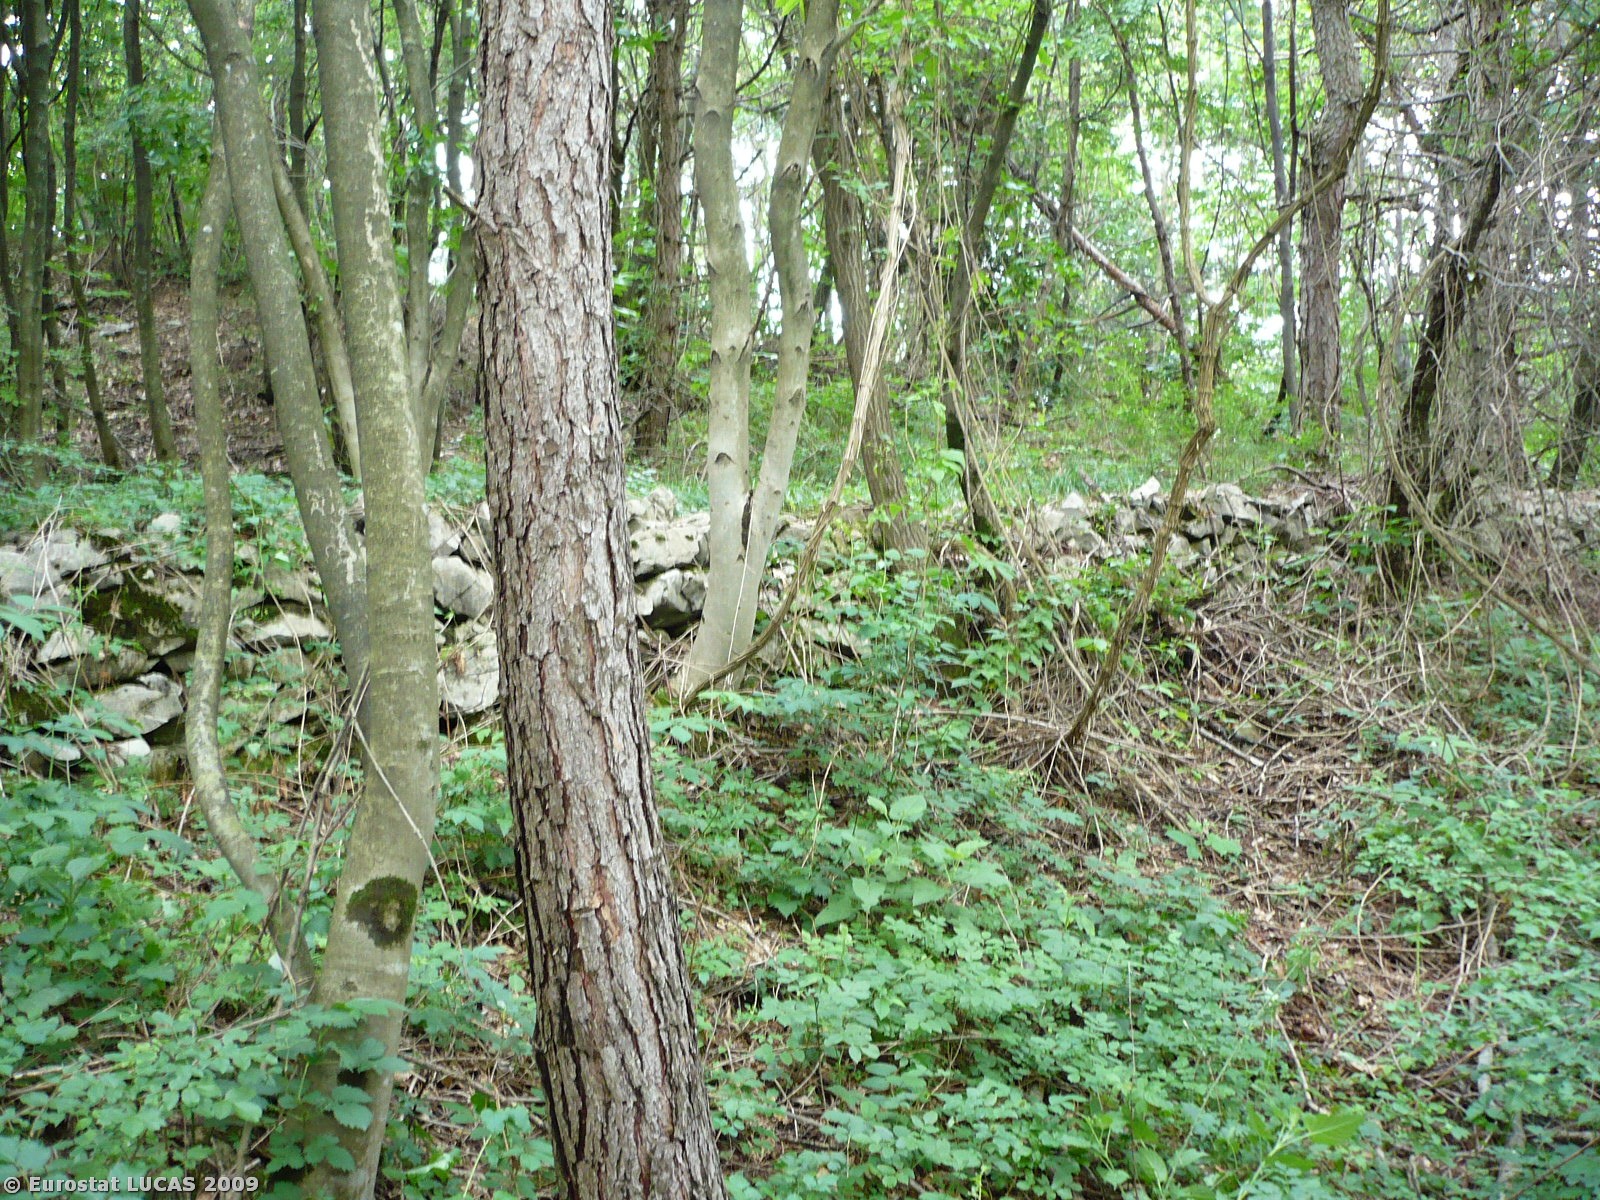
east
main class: Woodland
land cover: Broadleaved woodland
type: thermophilous deciduous forest
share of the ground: > 75 %
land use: Unused
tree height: > 5 m
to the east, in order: Broadleaved woodland; Dry stone walls; Tracks; Broadleaved woodland; Dry stone walls; Broadleaved woodland; Mixed woodland; Tracks; Broadleaved woodland; Ditches and canals; Coniferous woodland; Tracks; Broadleaved woodland; Mixed woodland; Tracks; Mixed woodland
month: June
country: SI
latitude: 46.0364
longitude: 13.6529
